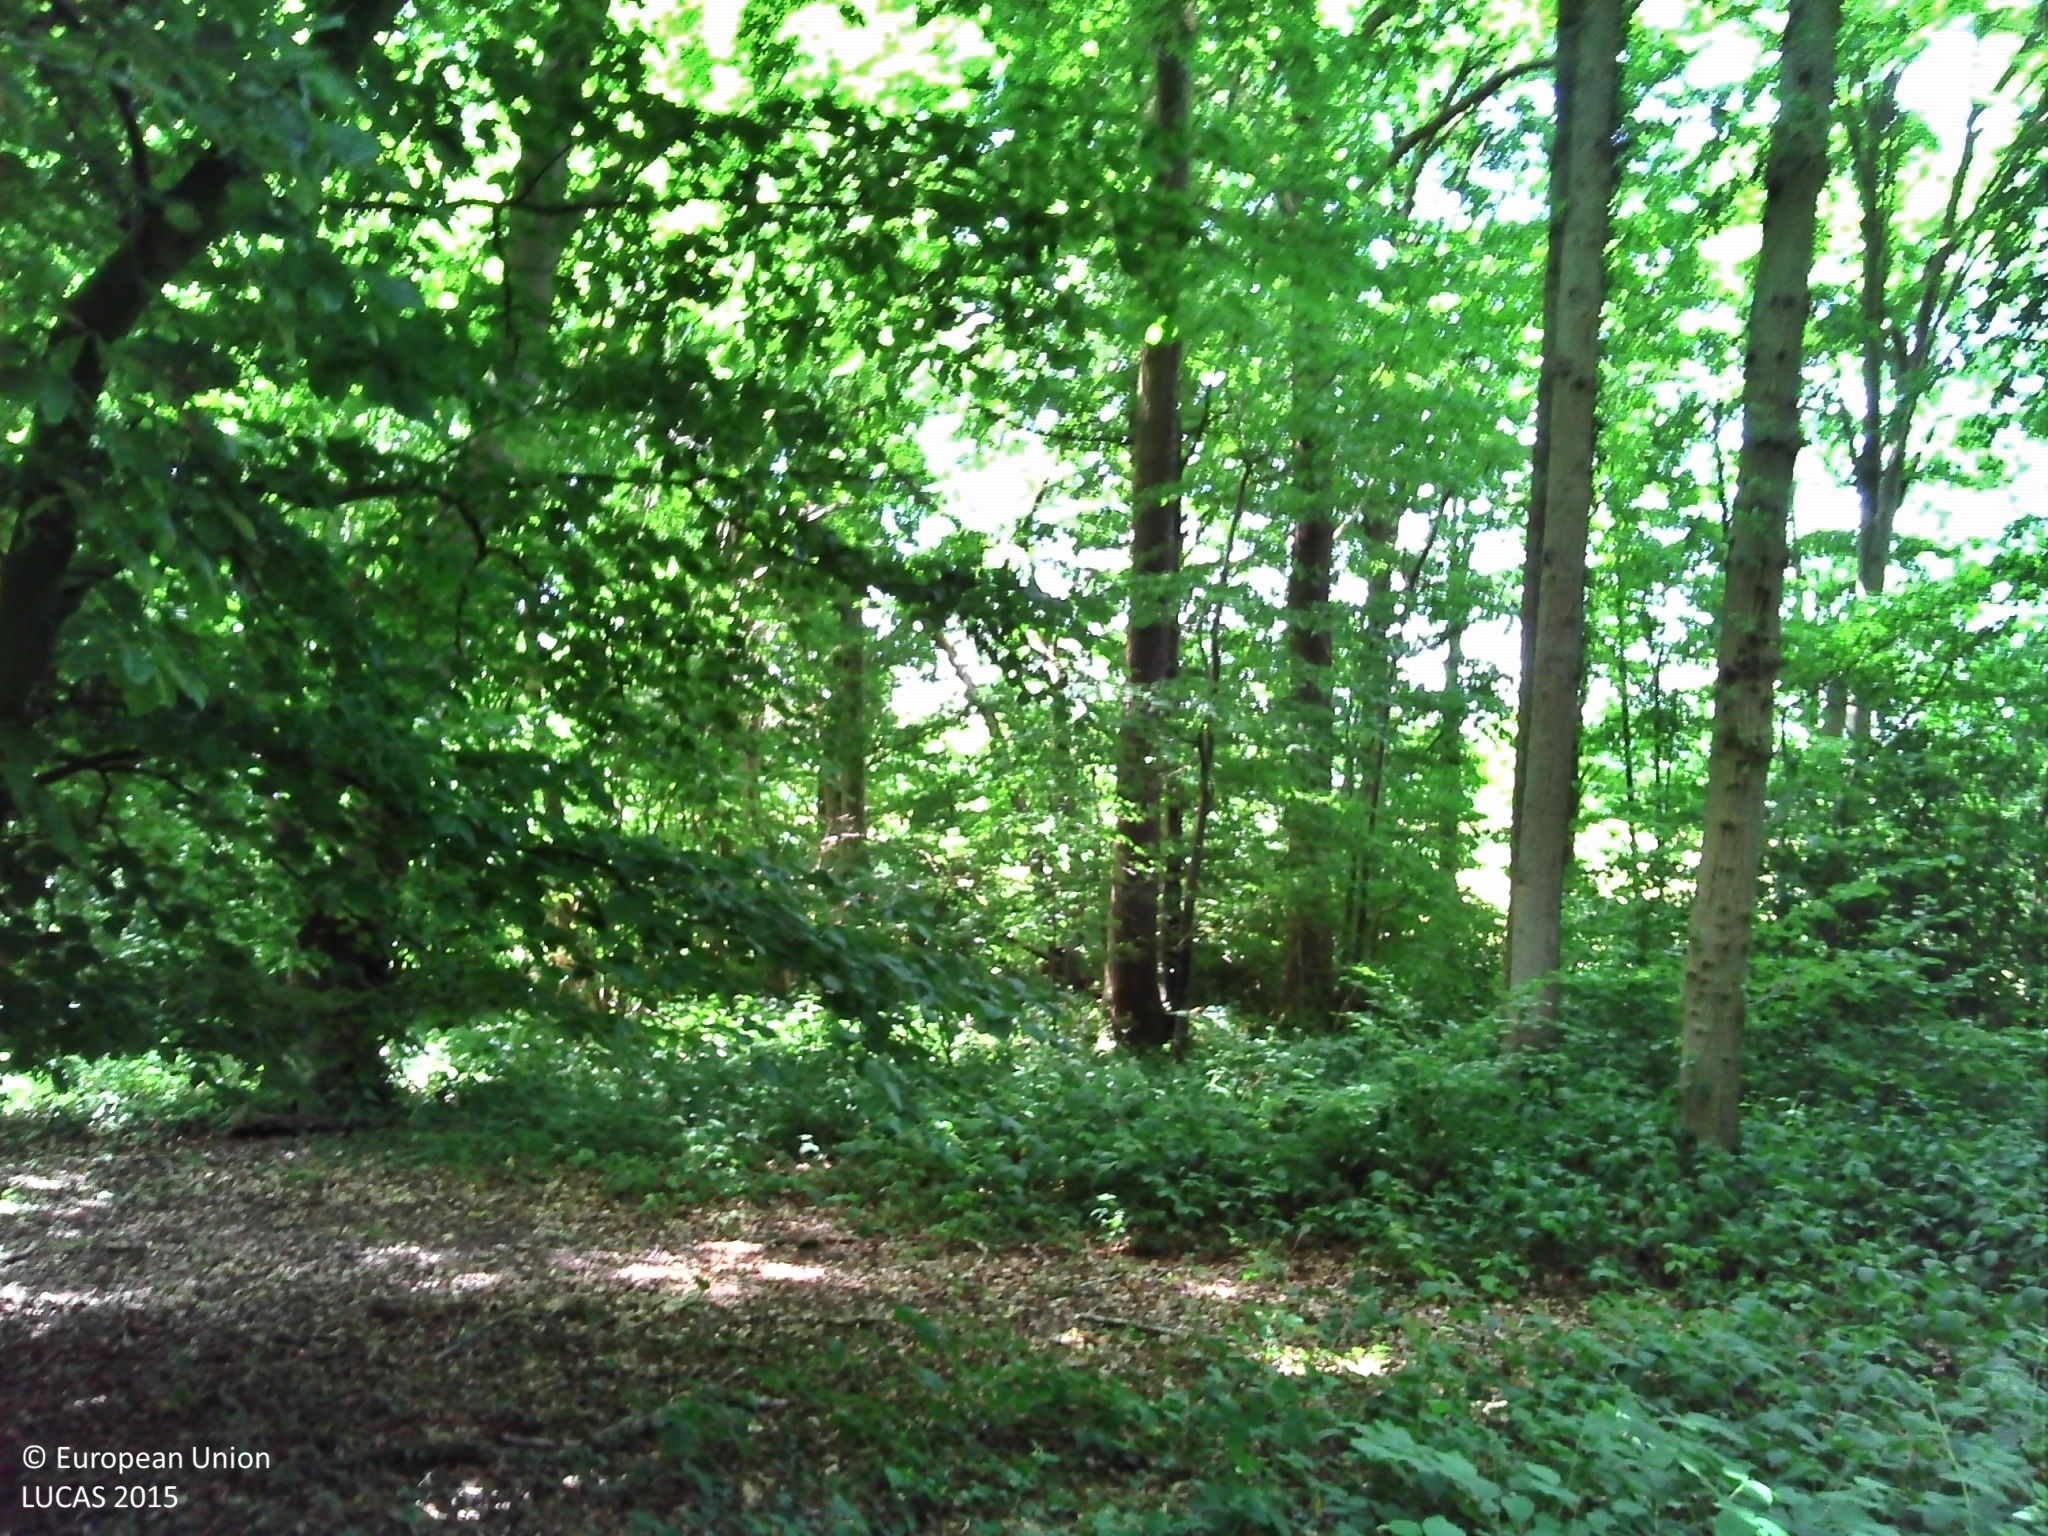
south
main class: Woodland
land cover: Broadleaved woodland
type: beech forest
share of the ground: > 75 %
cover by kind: broadleaved forest trees 80 %, herbaceous plants 15 %, shrubs 5 %
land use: Forestry
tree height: > 5 m
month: June
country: FR
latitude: 49.5218
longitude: 2.2367
